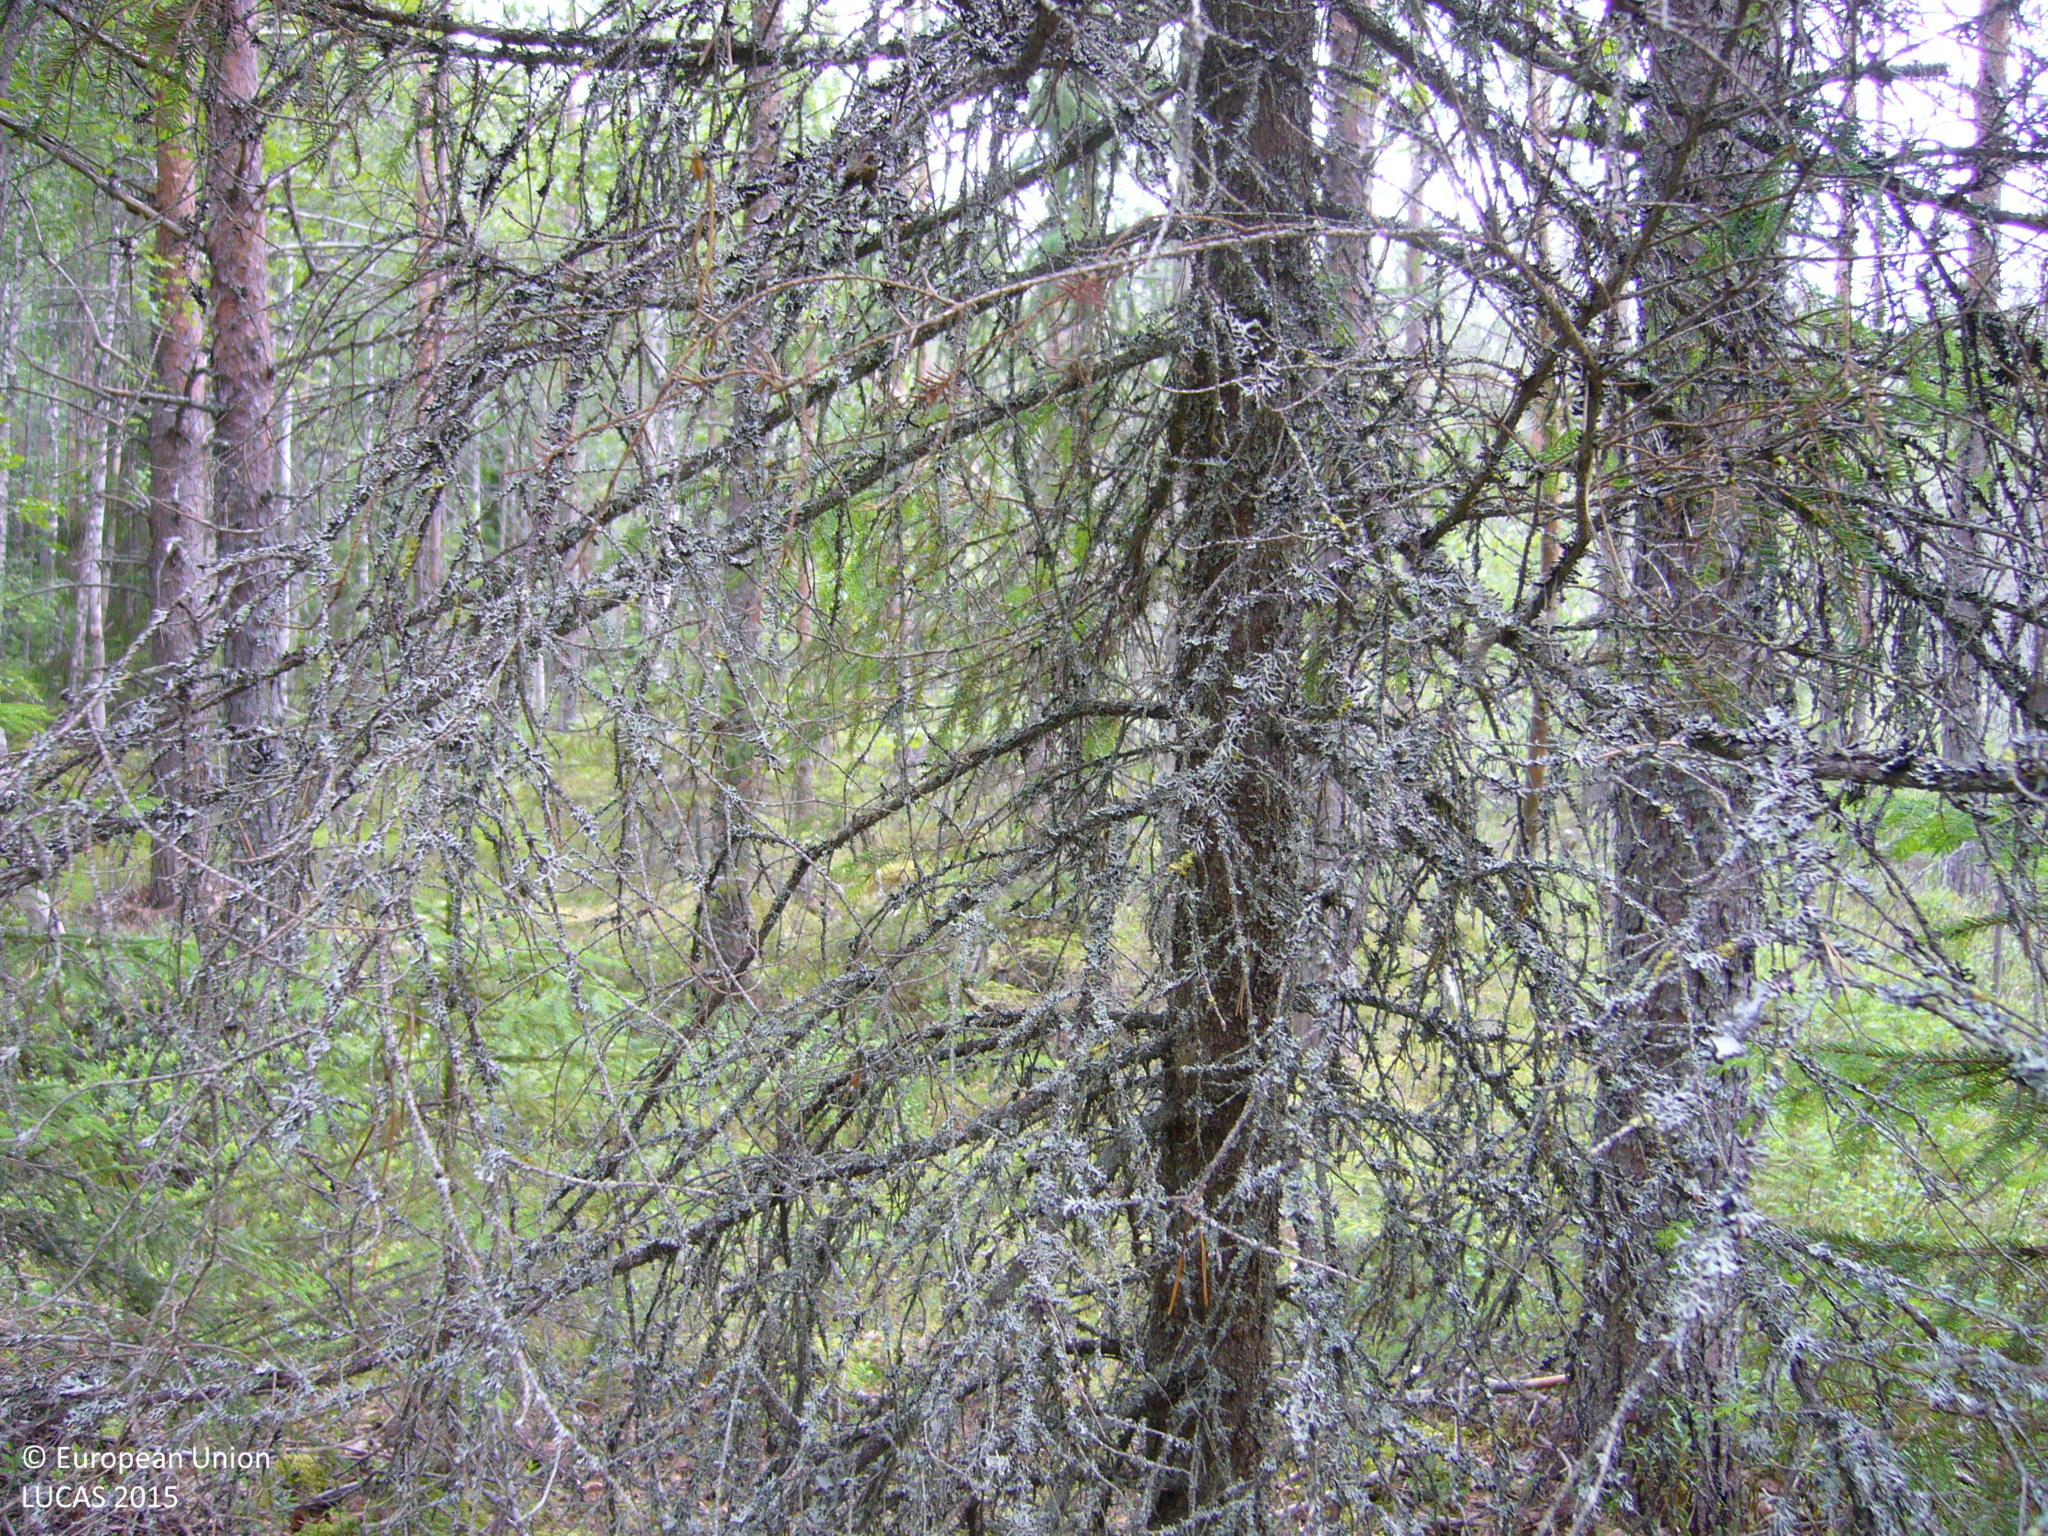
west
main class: Woodland
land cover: Pine dominated mixed woodland
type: boreal forest
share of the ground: > 75 %
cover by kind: coniferous forest trees 50 %, broadleaved forest trees 30 %, shrubs 20 %
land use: Forestry
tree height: > 5 m
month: July
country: FI
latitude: 63.5037
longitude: 26.0052
